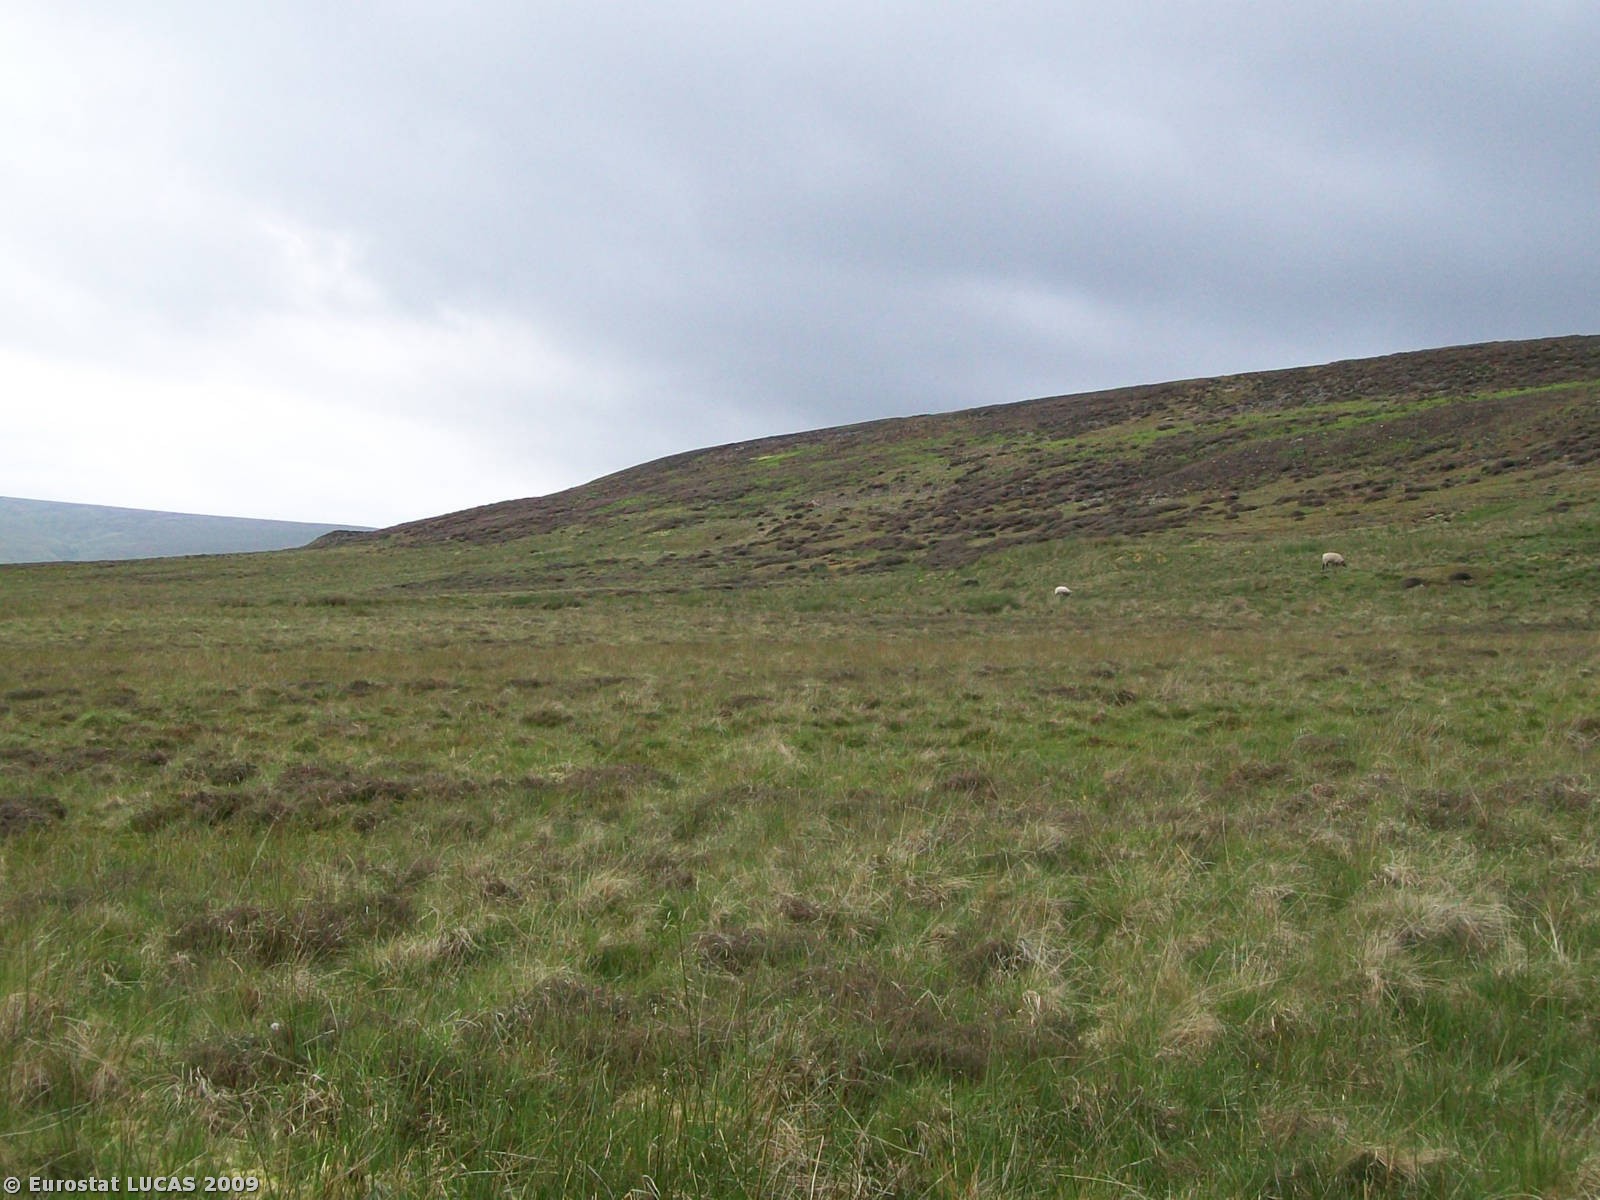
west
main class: Shrubland
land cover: Shrubland without tree cover
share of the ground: > 75 %
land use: Agriculture (excluding fallow land and kitchen gardens)
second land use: Nature reserves
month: June
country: GB
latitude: 54.7132
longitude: -1.9919
